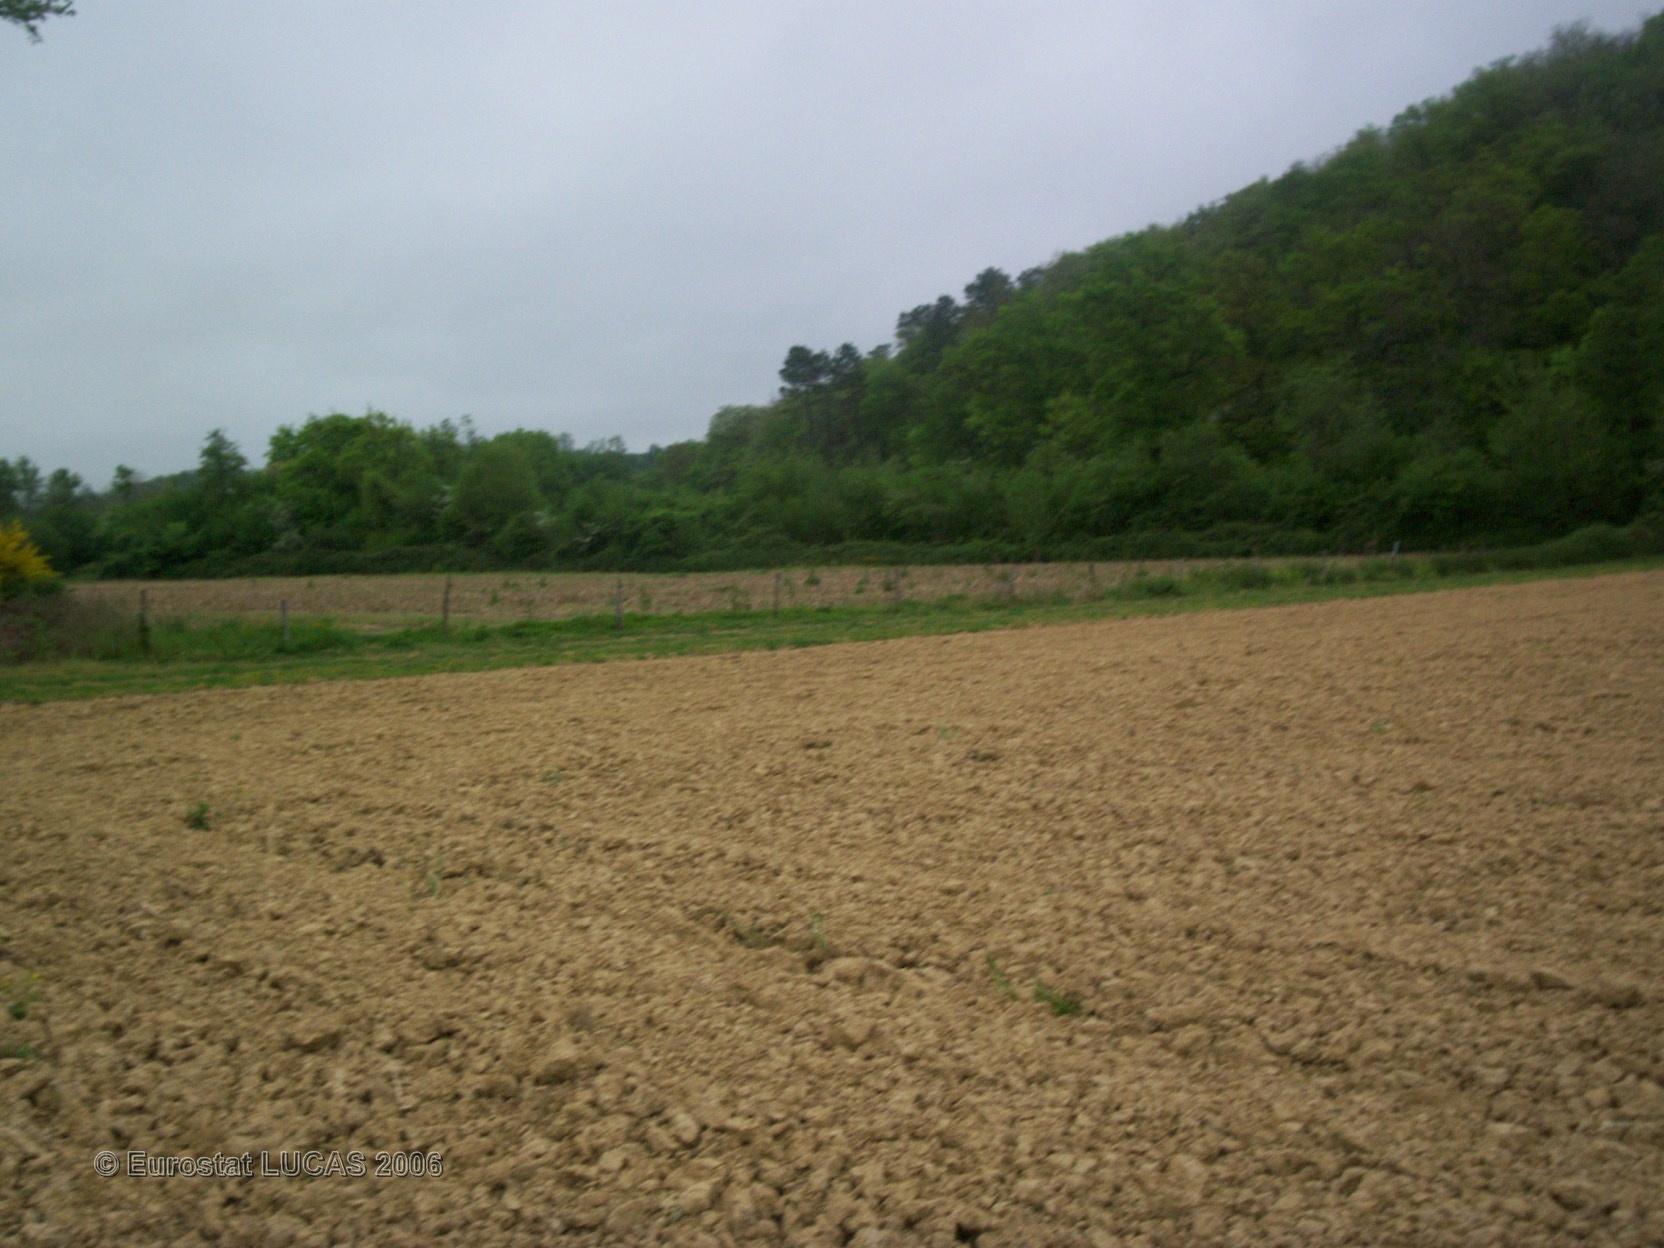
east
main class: Cropland
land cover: Maize
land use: Agriculture (excluding fallow land and kitchen gardens)
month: June
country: FR
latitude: 43.5774
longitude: -0.3486
